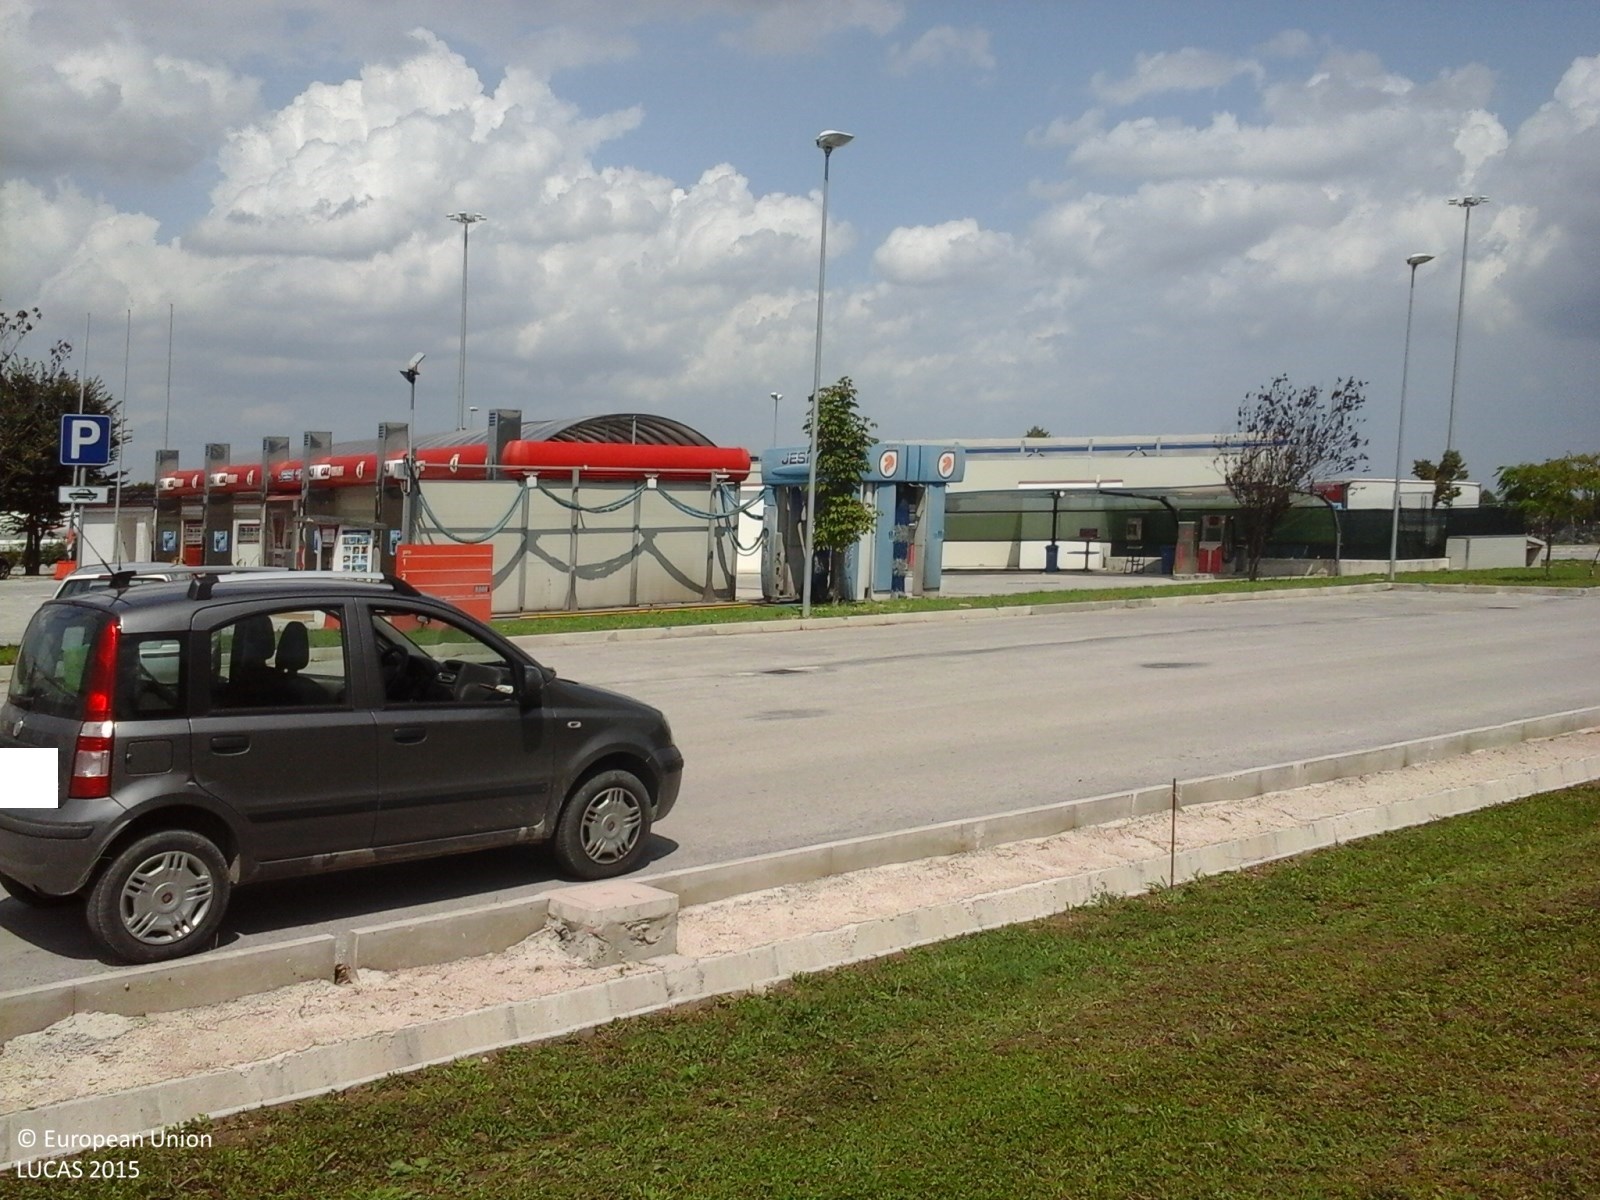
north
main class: Grassland
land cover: Grassland without tree/shrub cover
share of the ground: > 75 %
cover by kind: herbaceous plants 100 %
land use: Community services
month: August
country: IT
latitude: 43.4882
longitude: 13.2193
